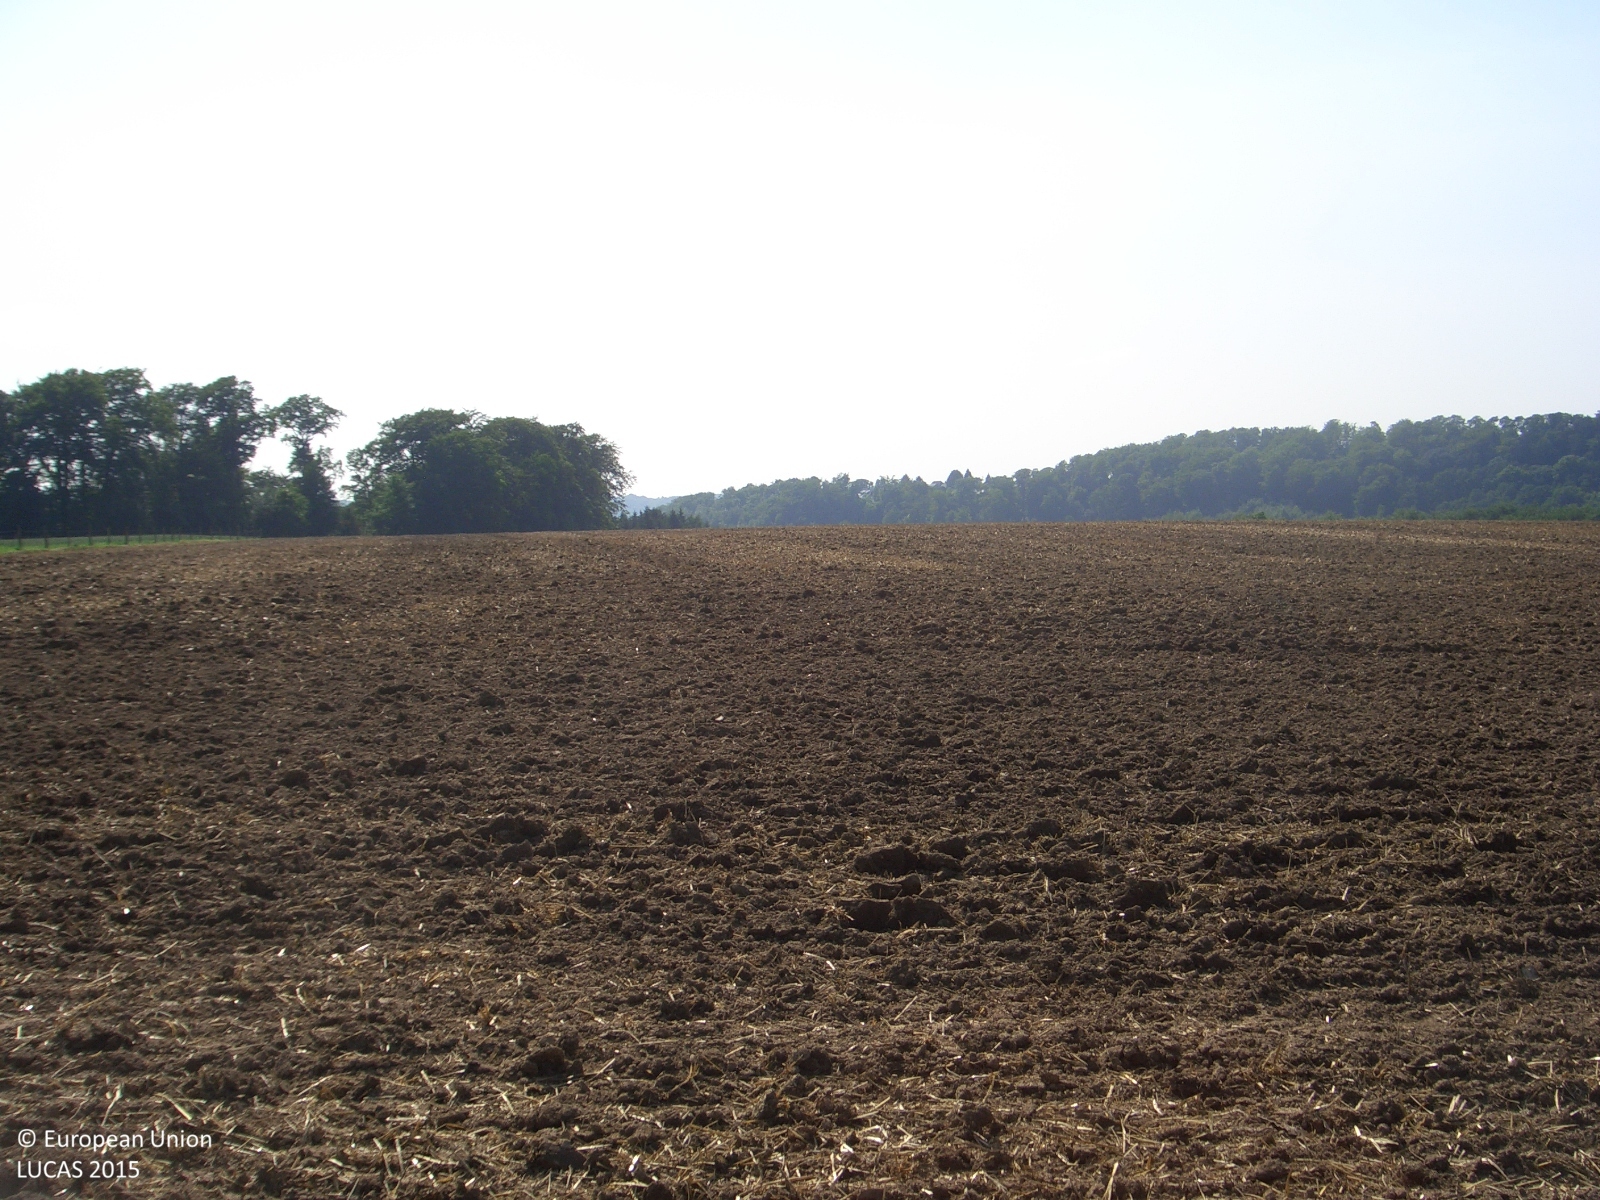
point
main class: Cropland
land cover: Barley
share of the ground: < 10 %
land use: Agriculture (excluding fallow land and kitchen gardens)
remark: Harvested field
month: July
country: DE
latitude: 51.3674
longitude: 6.9692
